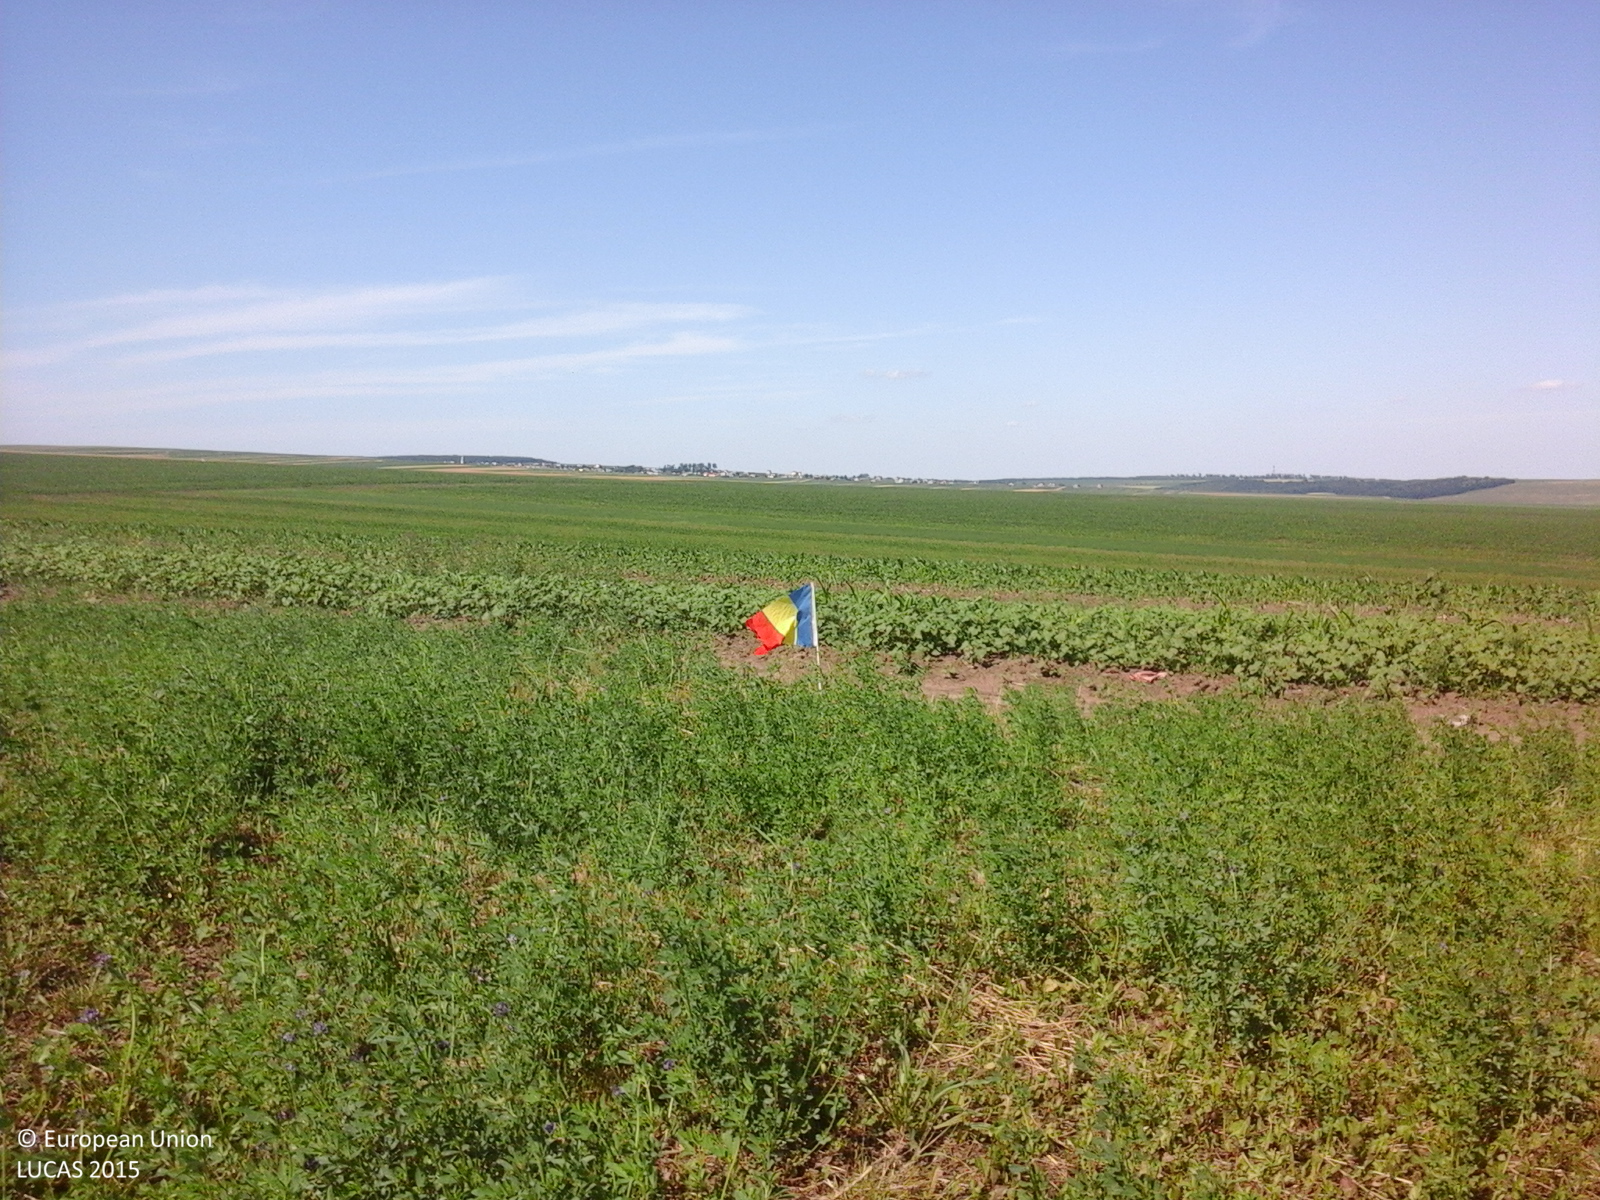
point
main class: Cropland
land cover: Lucerne
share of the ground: > 75 %
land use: Agriculture (excluding fallow land and kitchen gardens)
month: June
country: RO
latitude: 47.1299
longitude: 26.8791
